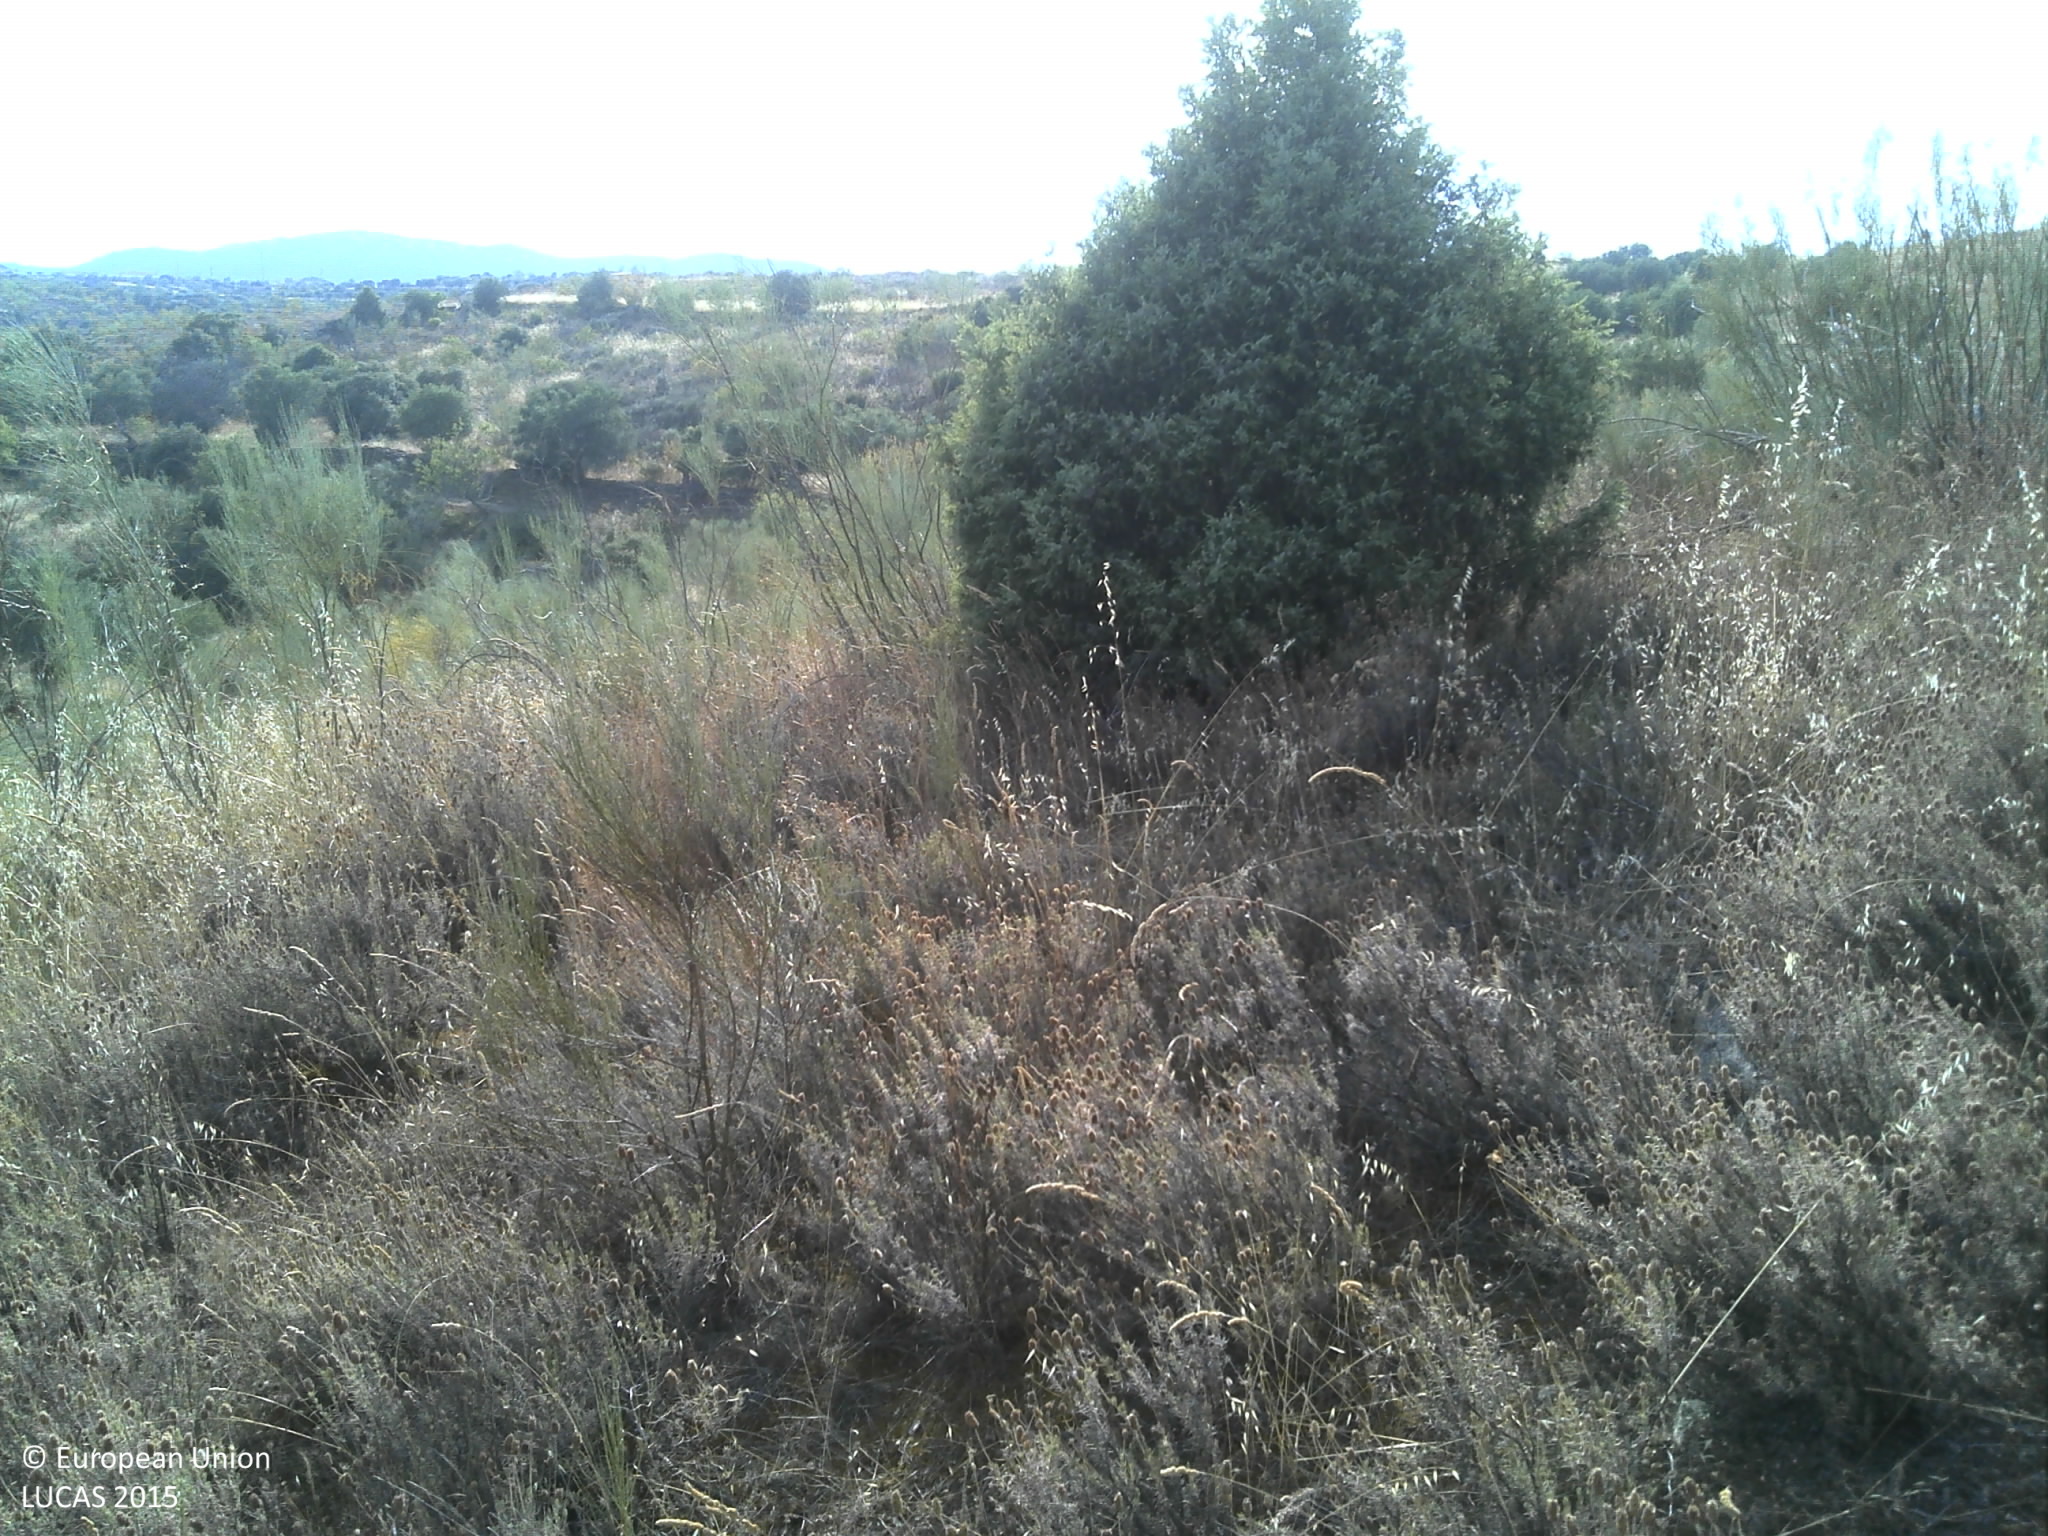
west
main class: Shrubland
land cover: Shrubland with sparse tree cover
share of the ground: > 75 %
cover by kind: shrubs 75 %, herbaceous plants 15 %, broadleaved forest trees 5 %, unconsolidated bare surface 5 %
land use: Abandoned areas
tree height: < 5 m
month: July
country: PT
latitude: 41.0909
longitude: -7.1233
